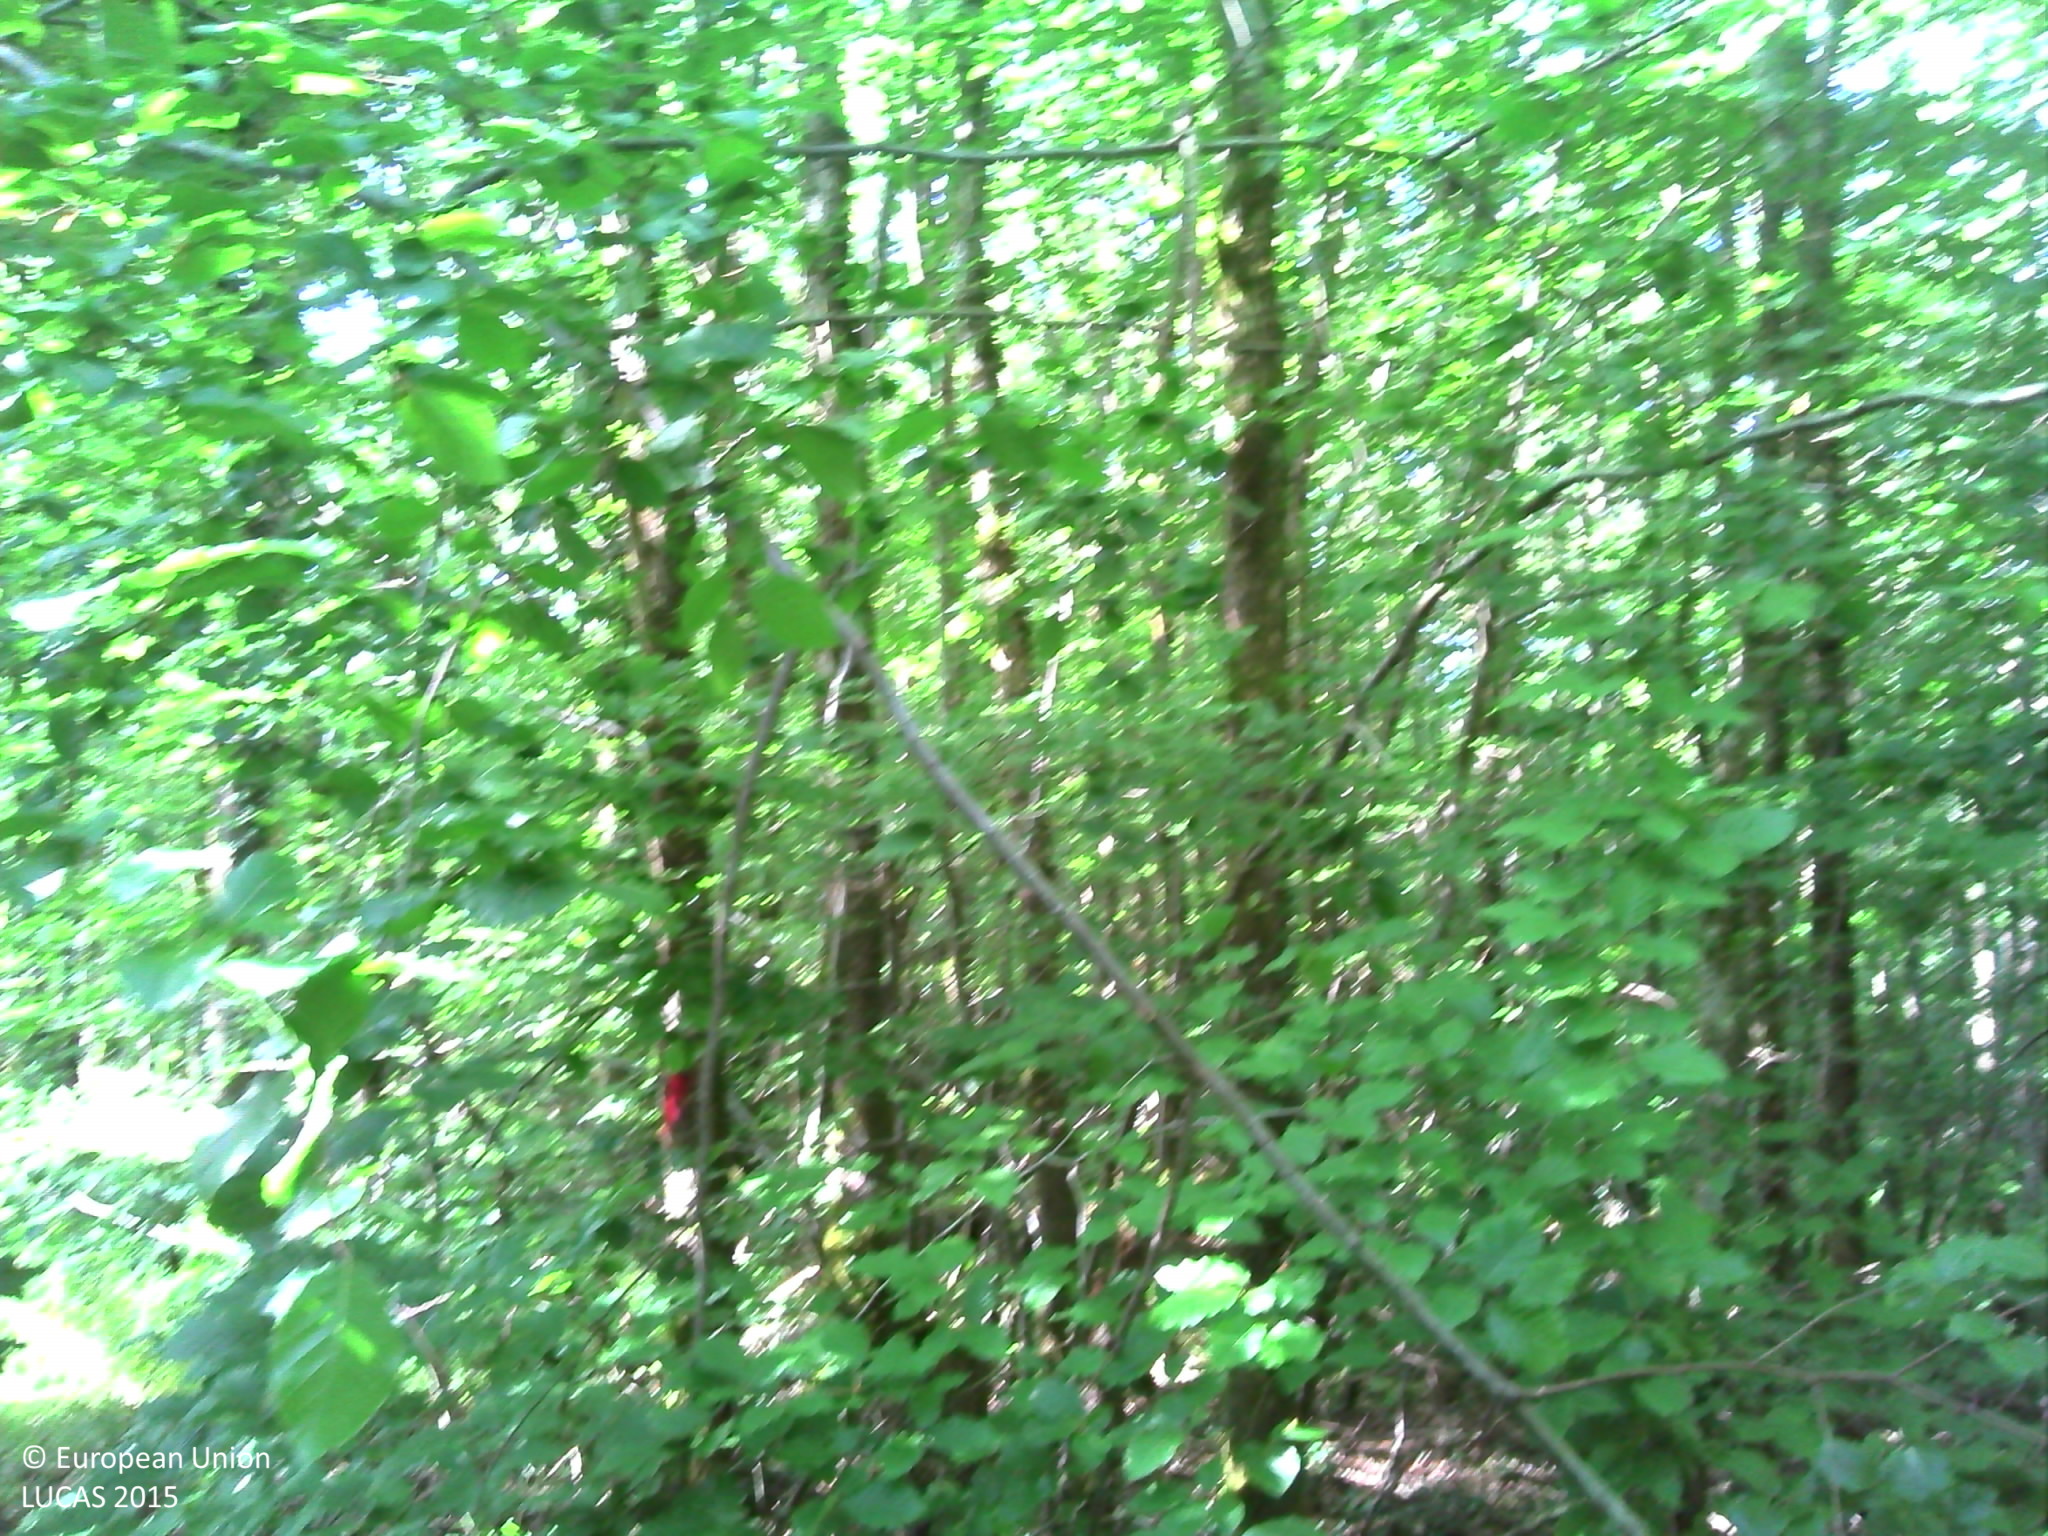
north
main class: Woodland
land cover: Broadleaved woodland
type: beech forest
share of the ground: > 75 %
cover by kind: broadleaved forest trees 75 %, herbaceous plants 15 %, shrubs 10 %
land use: Forestry
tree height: > 5 m
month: June
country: FR
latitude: 48.4051
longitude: 0.2333
